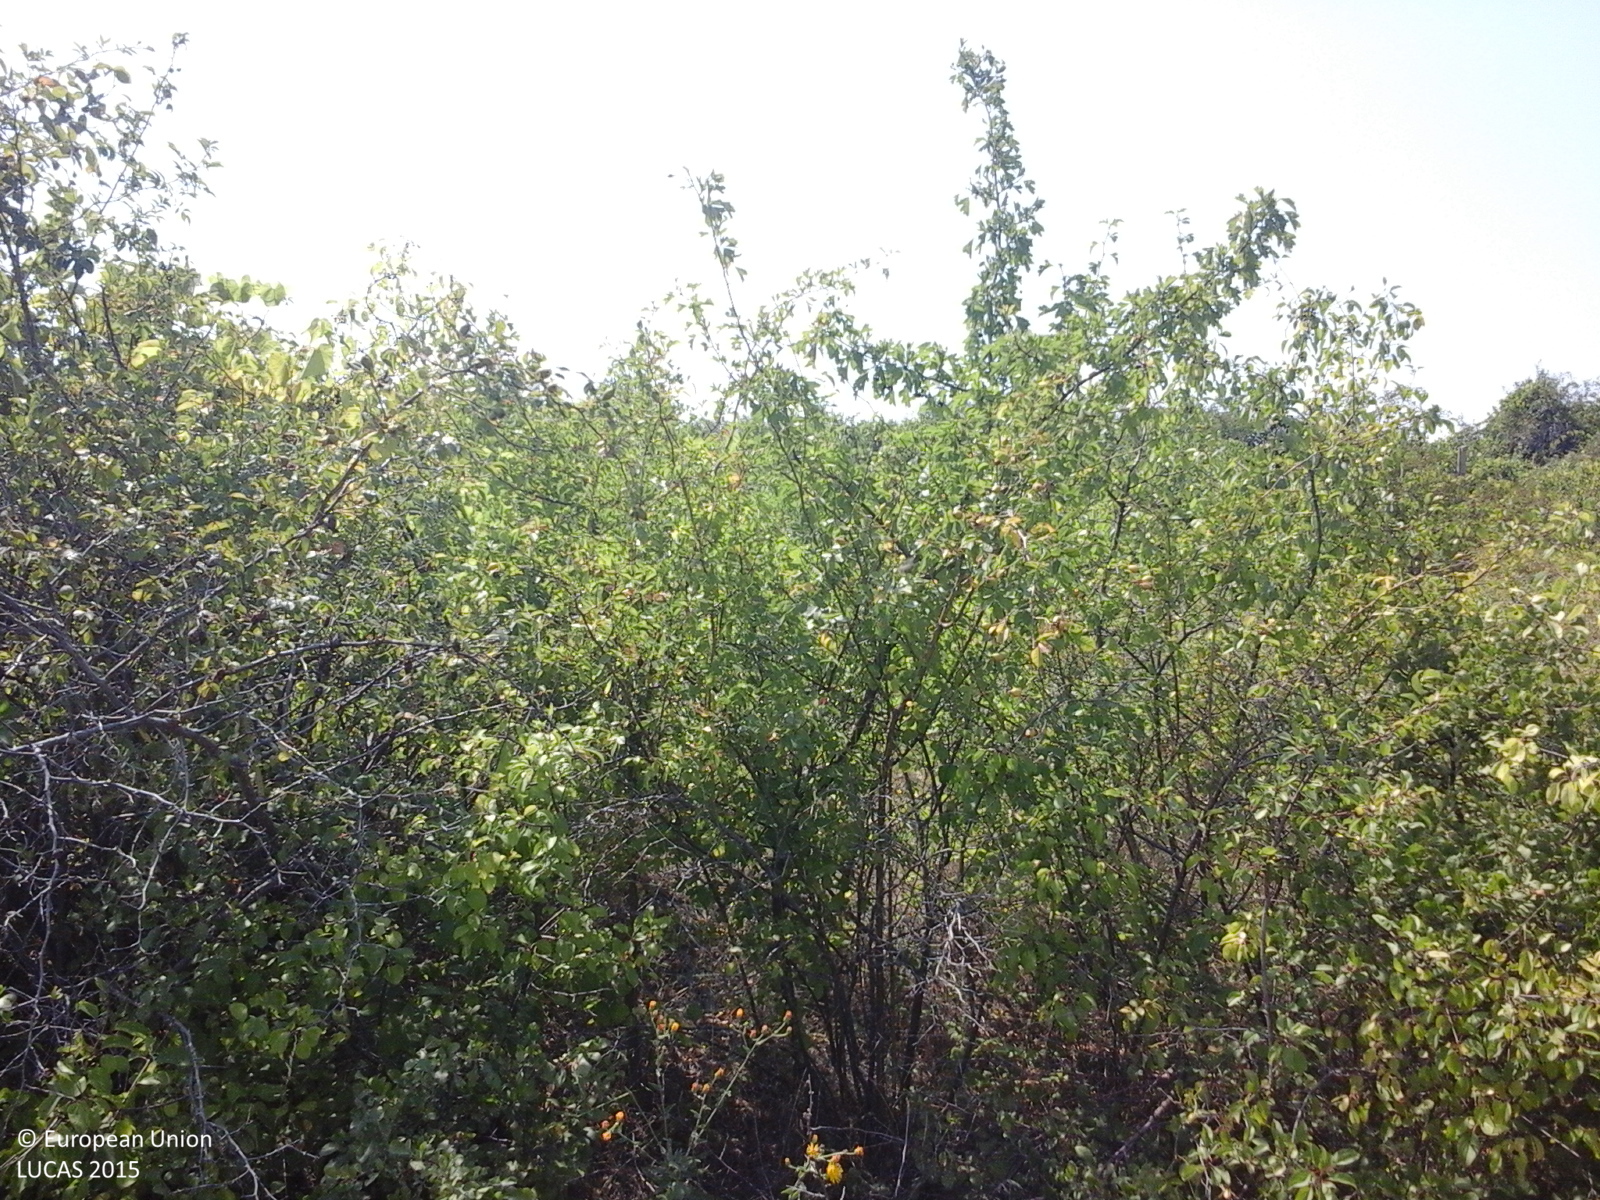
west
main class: Cropland
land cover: Vineyards
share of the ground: > 75 %
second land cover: Other bare soil
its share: > 75 %
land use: Agriculture (excluding fallow land and kitchen gardens)
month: July
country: RO
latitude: 45.6128
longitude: 27.8221
